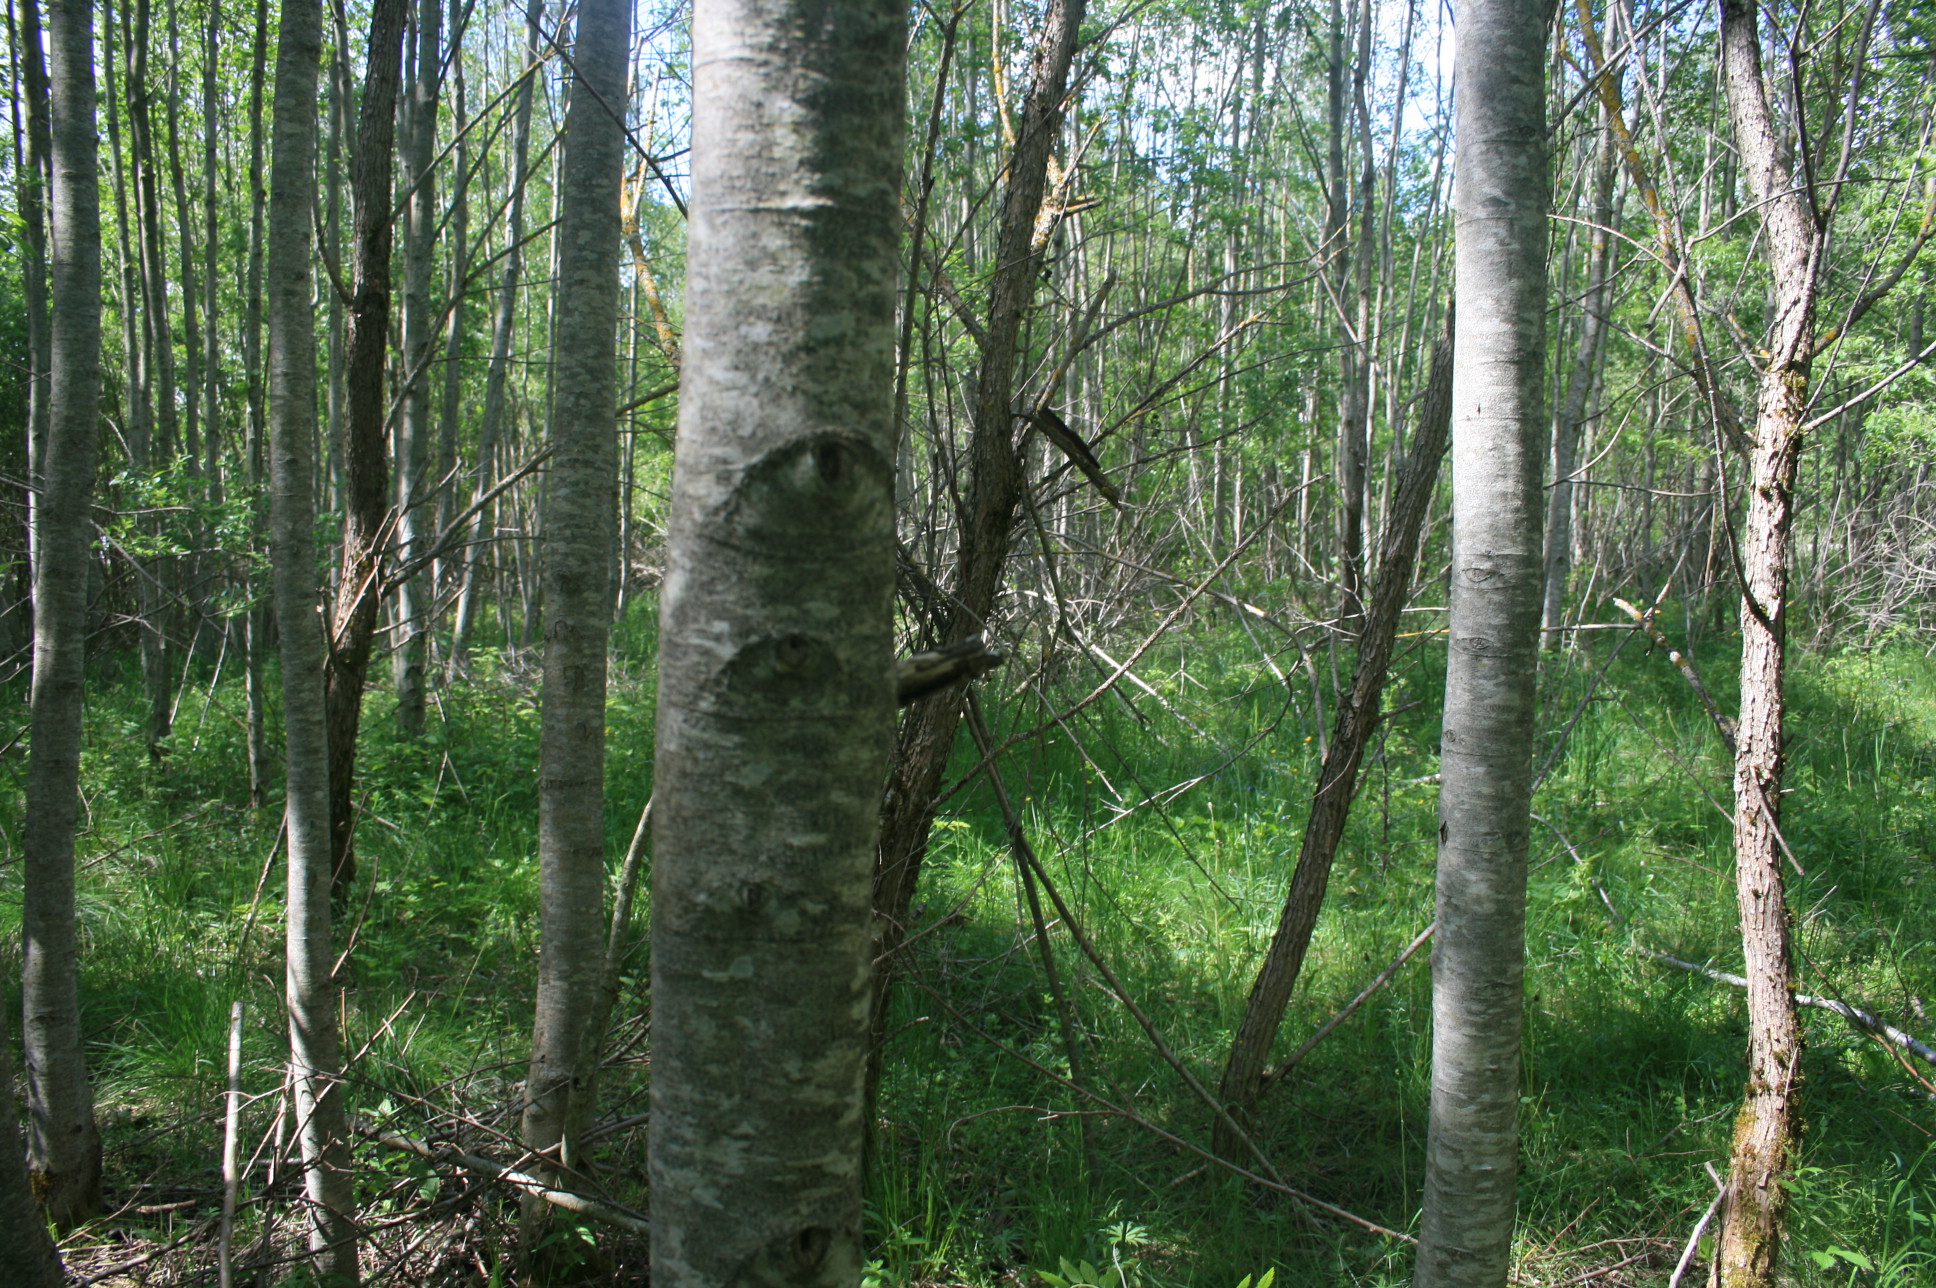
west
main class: Woodland
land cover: Broadleaved woodland
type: non-riverine alder, birch or aspen forest
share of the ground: > 75 %
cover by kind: broadleaved forest trees 95 %, herbaceous plants 5 %
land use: Forestry
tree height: > 5 m
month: June
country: LT
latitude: 56.1509
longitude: 22.3712
